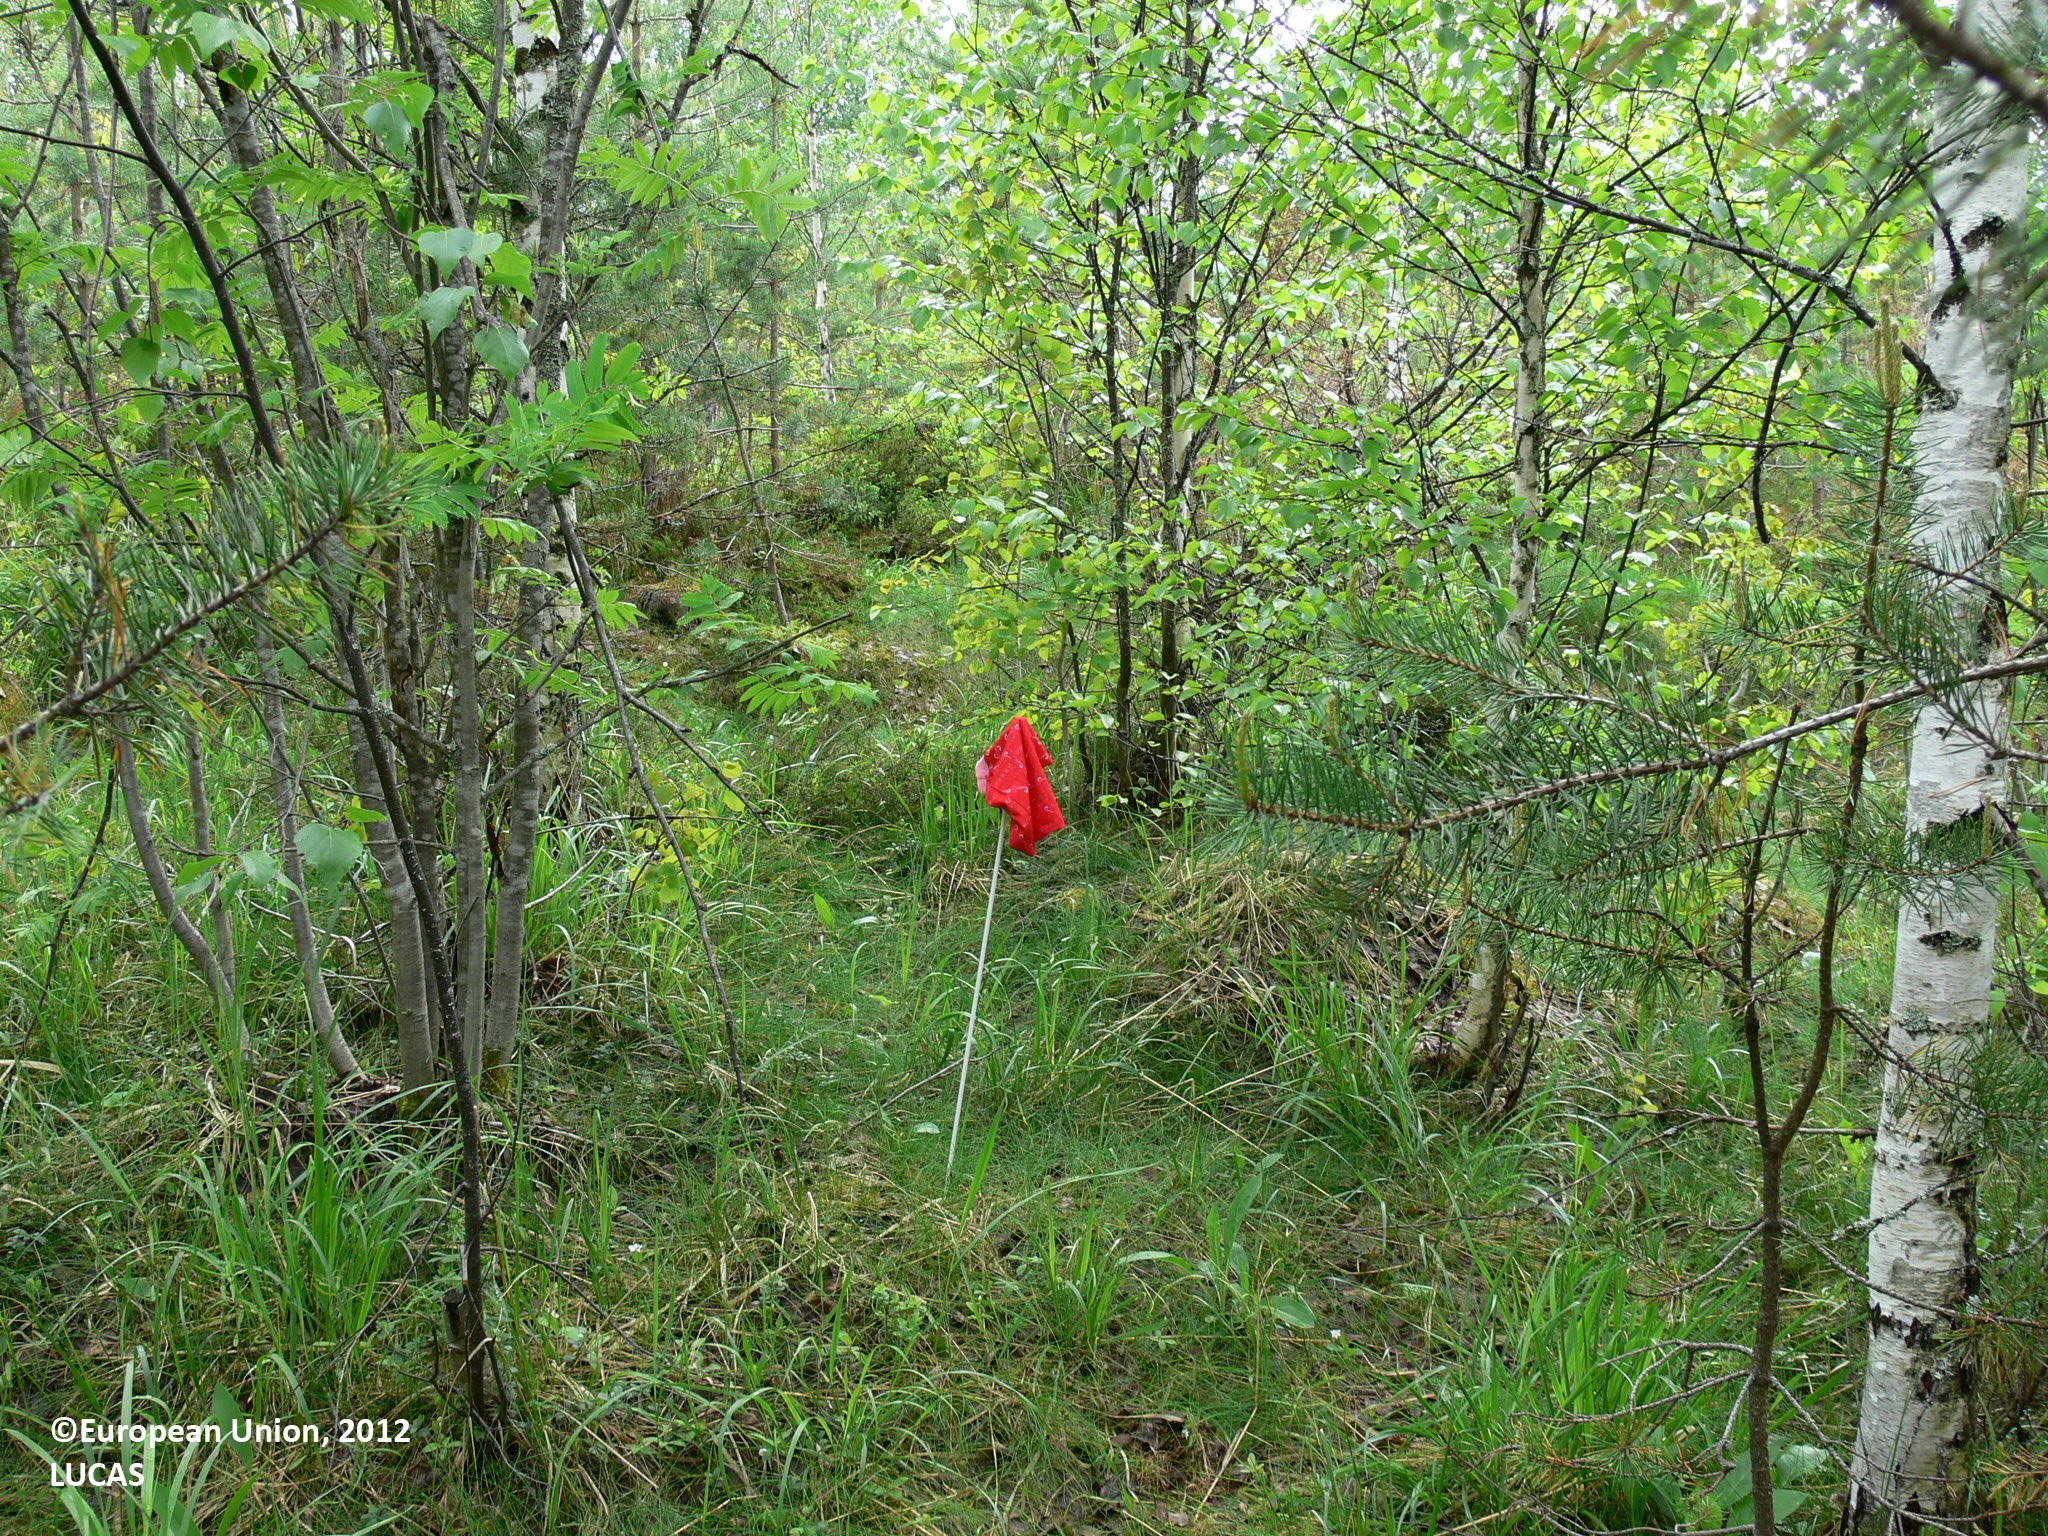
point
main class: Woodland
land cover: Other mixed woodland
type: boreal forest
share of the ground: 50 - 75 %
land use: Forestry
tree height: > 5 m
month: June
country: FI
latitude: 62.4256
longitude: 30.2768
